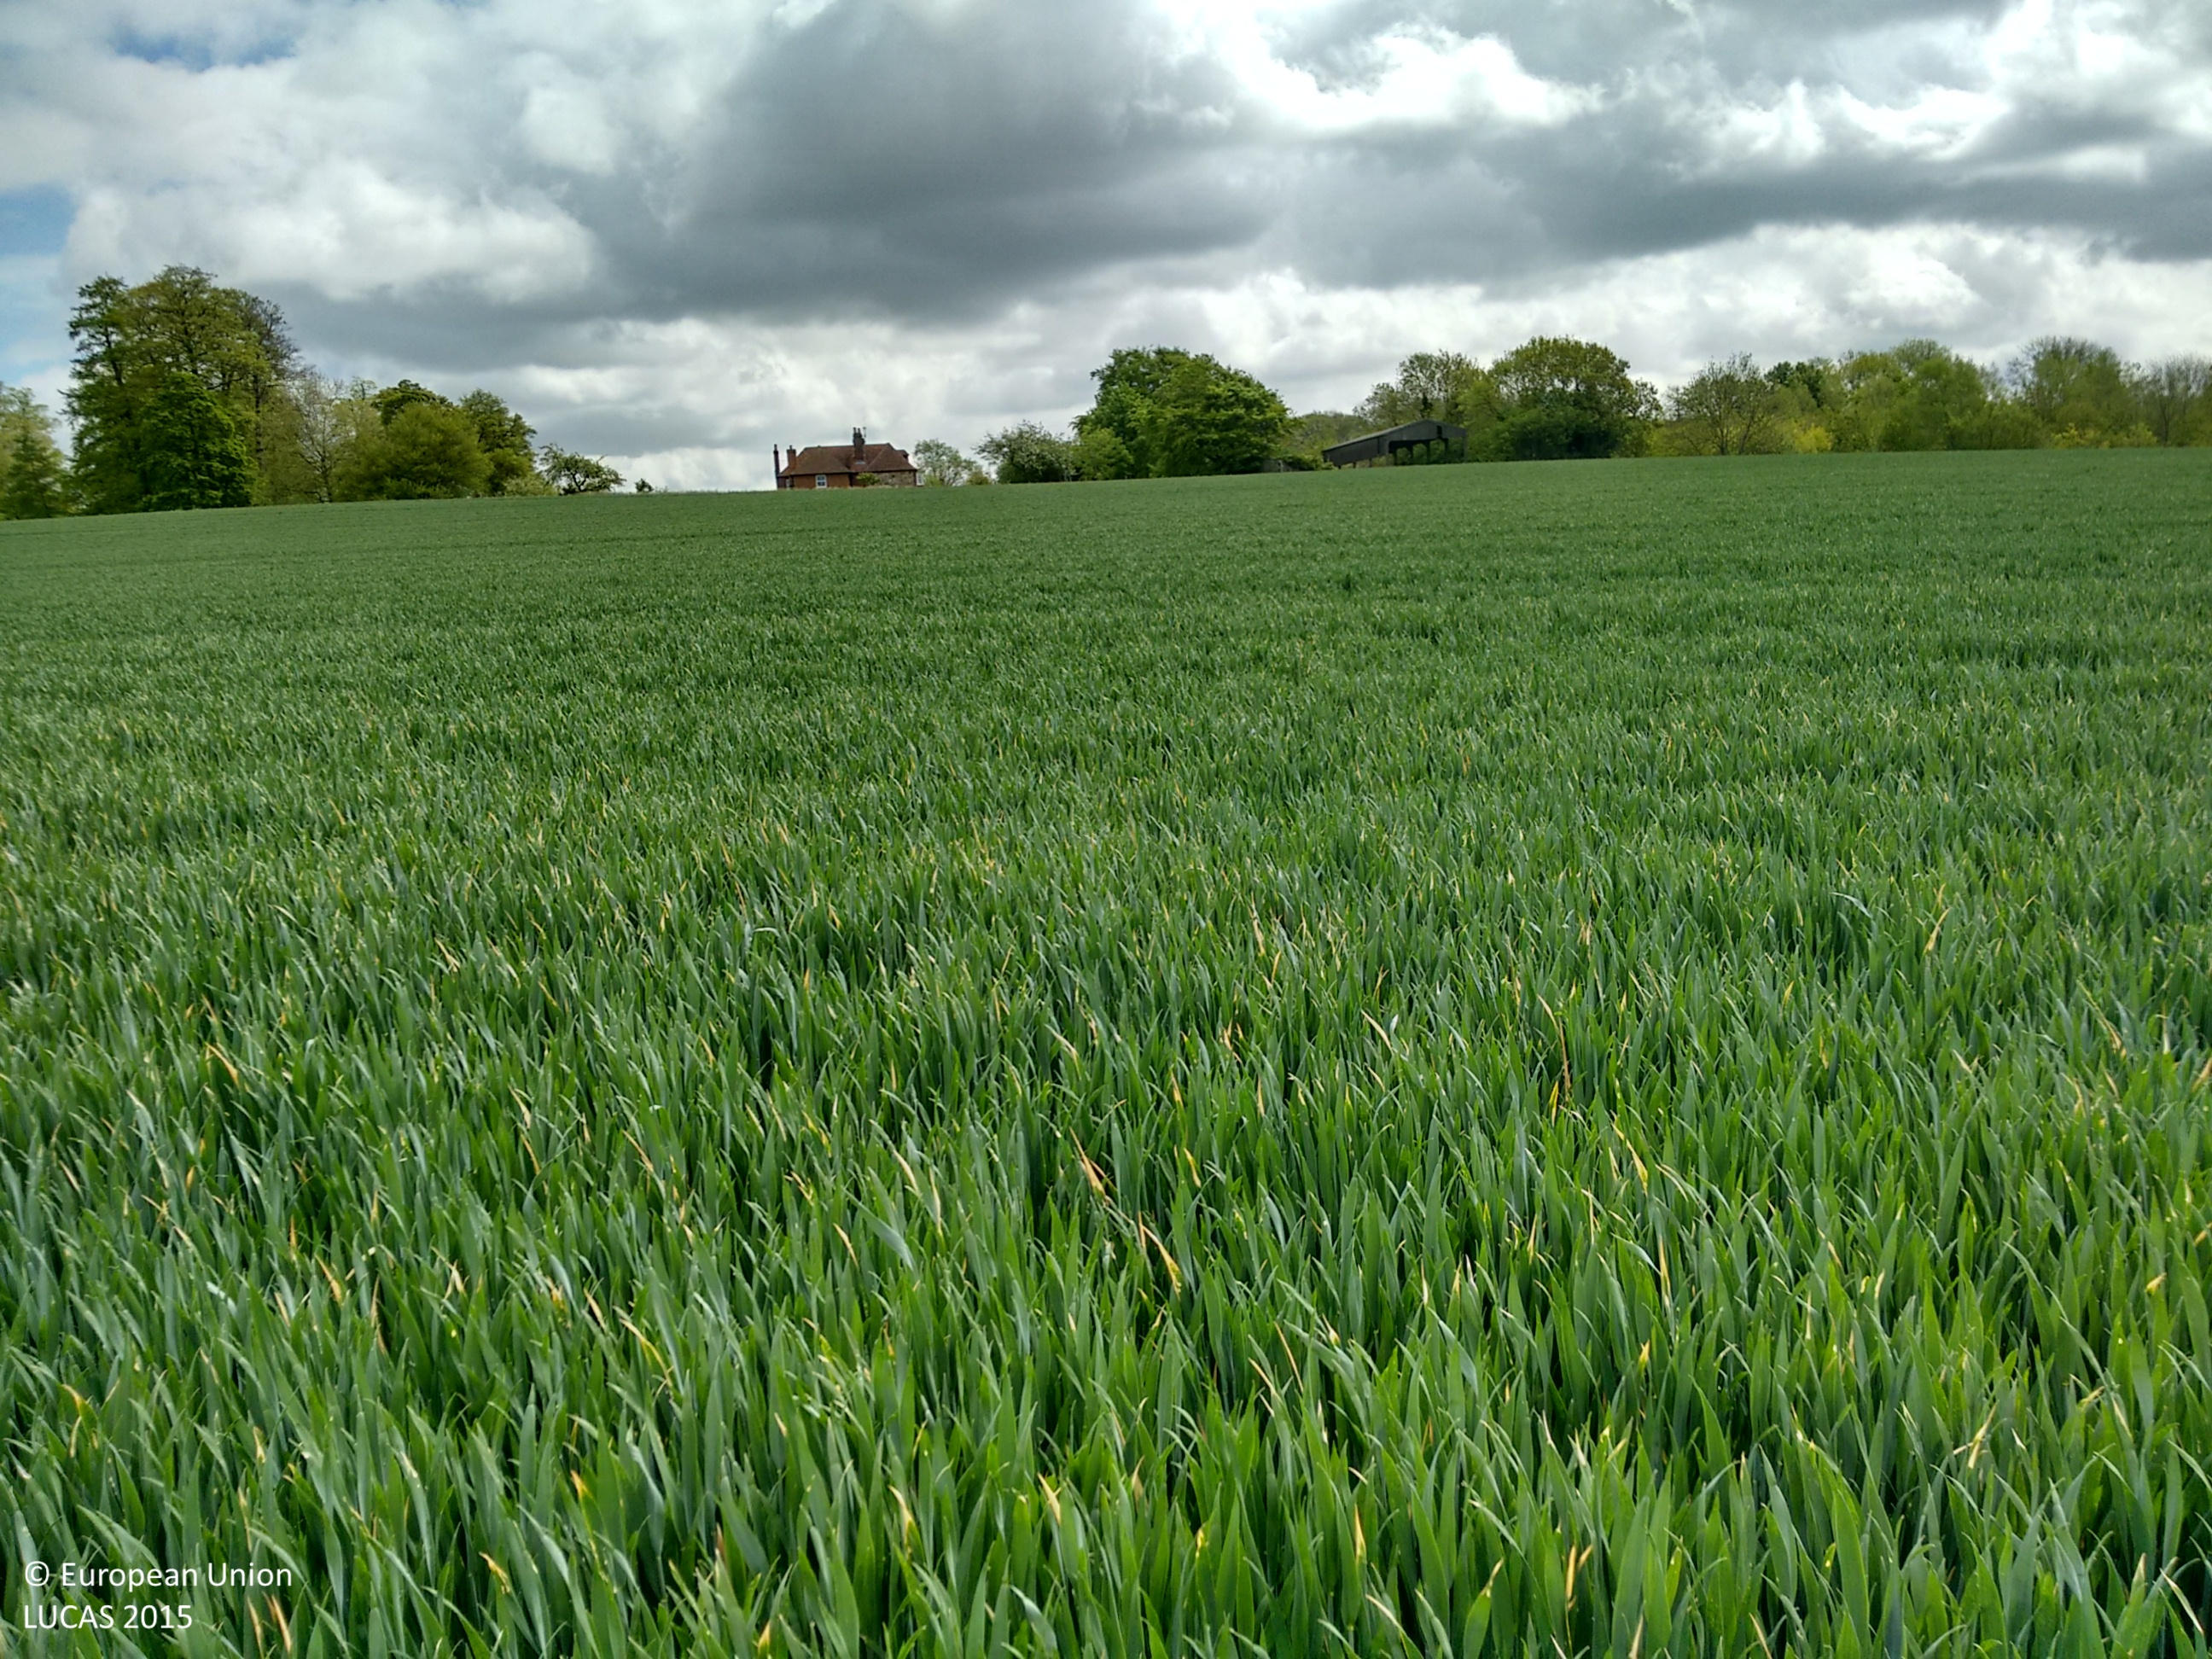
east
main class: Cropland
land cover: Common wheat
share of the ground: > 75 %
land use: Agriculture (excluding fallow land and kitchen gardens)
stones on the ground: < 10 %
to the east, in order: Common wheat; Shrubland without tree cover; Broadleaved woodland; Artificial constructions in urban areas; Inland fresh water bodies
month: May
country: GB
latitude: 51.3058
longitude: 0.2586
